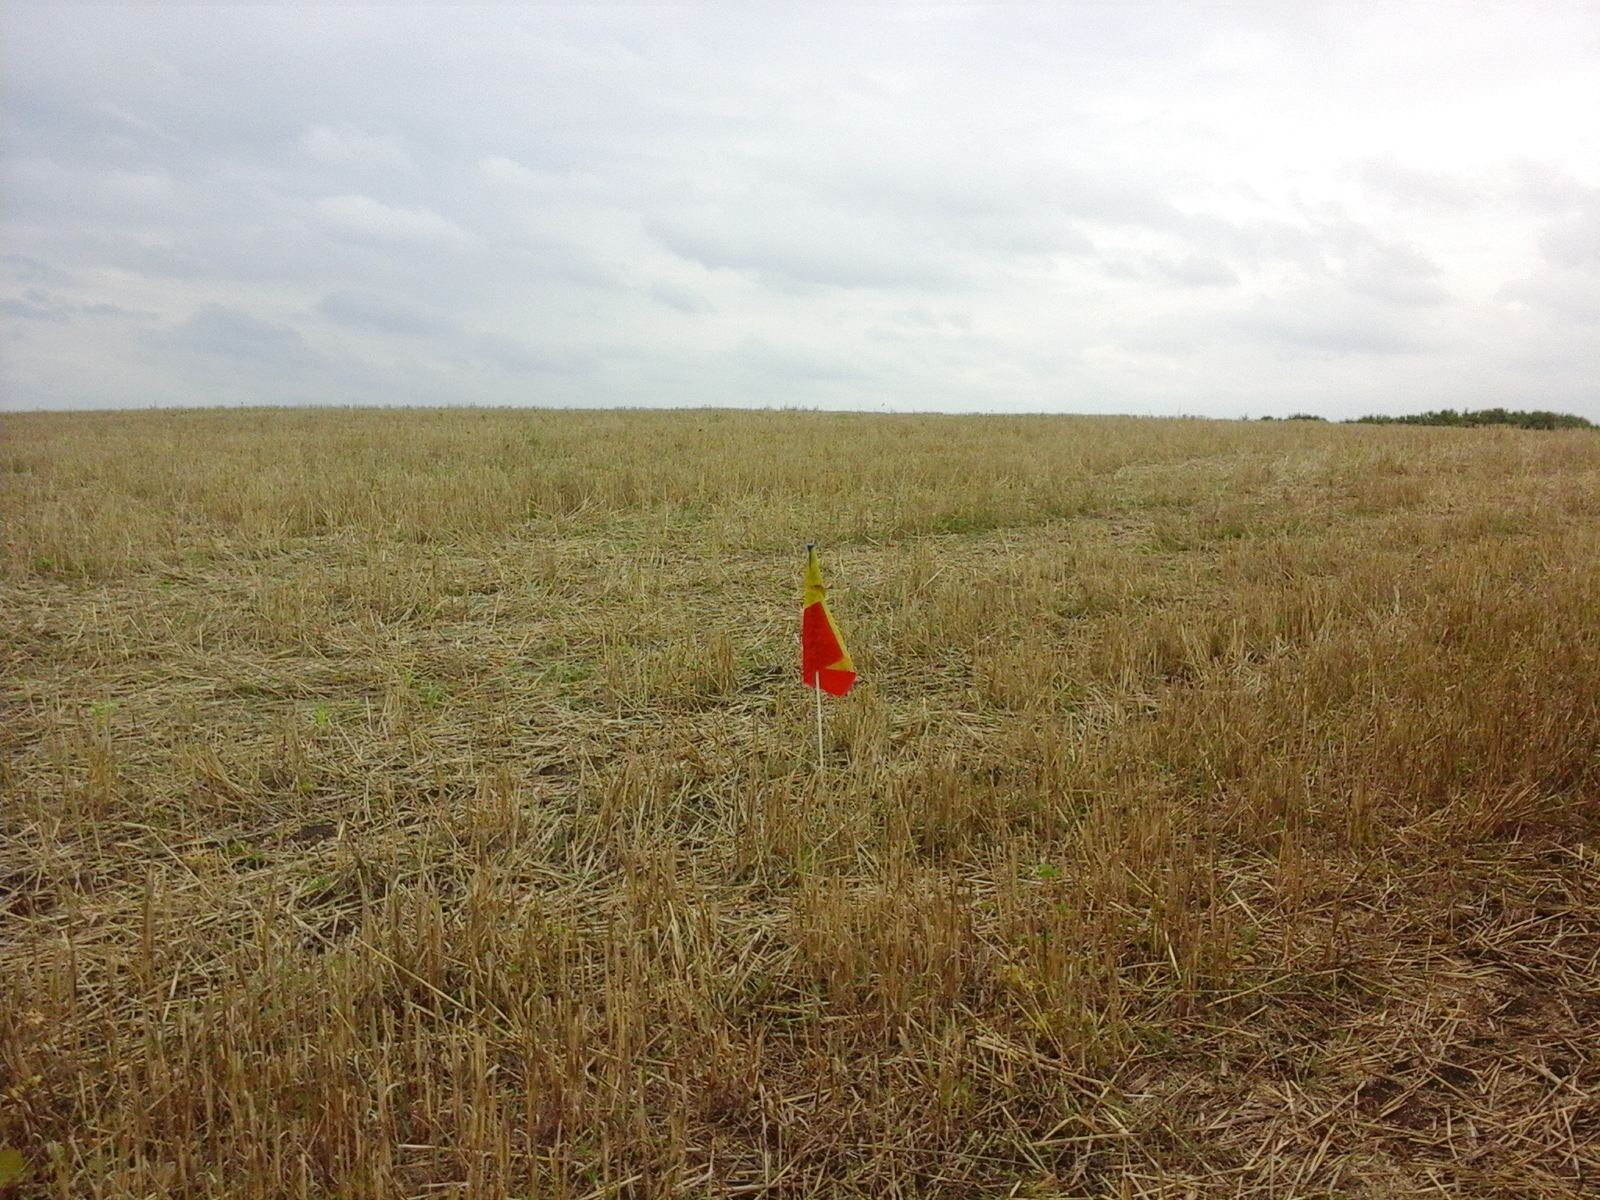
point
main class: Cropland
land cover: Common wheat
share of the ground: 50 - 75 %
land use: Agriculture (excluding fallow land and kitchen gardens)
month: August
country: RO
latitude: 45.5487
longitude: 21.3149
